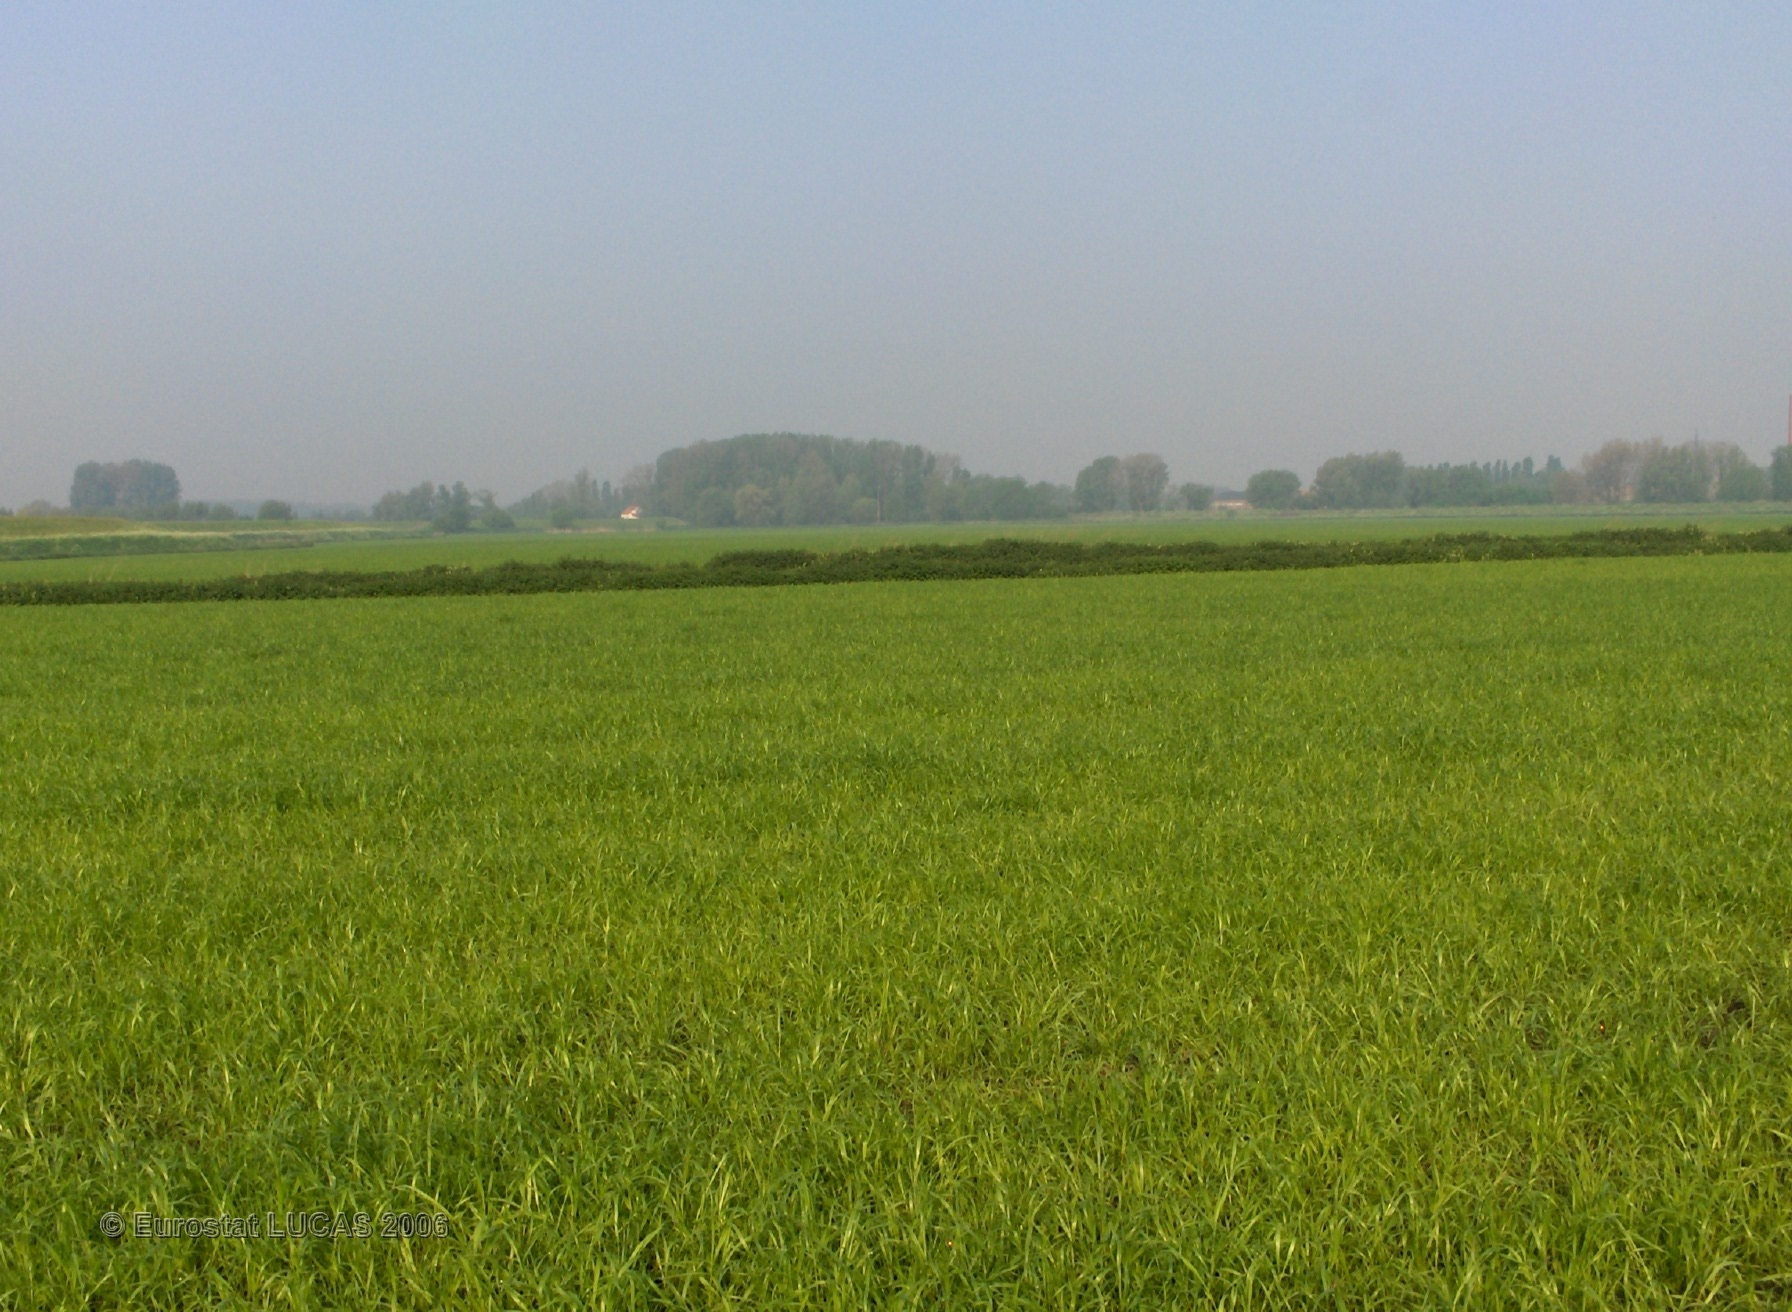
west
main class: Cropland
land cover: Triticale
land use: Agriculture (excluding fallow land and kitchen gardens)
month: May
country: BE
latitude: 51.0747
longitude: 4.4149
